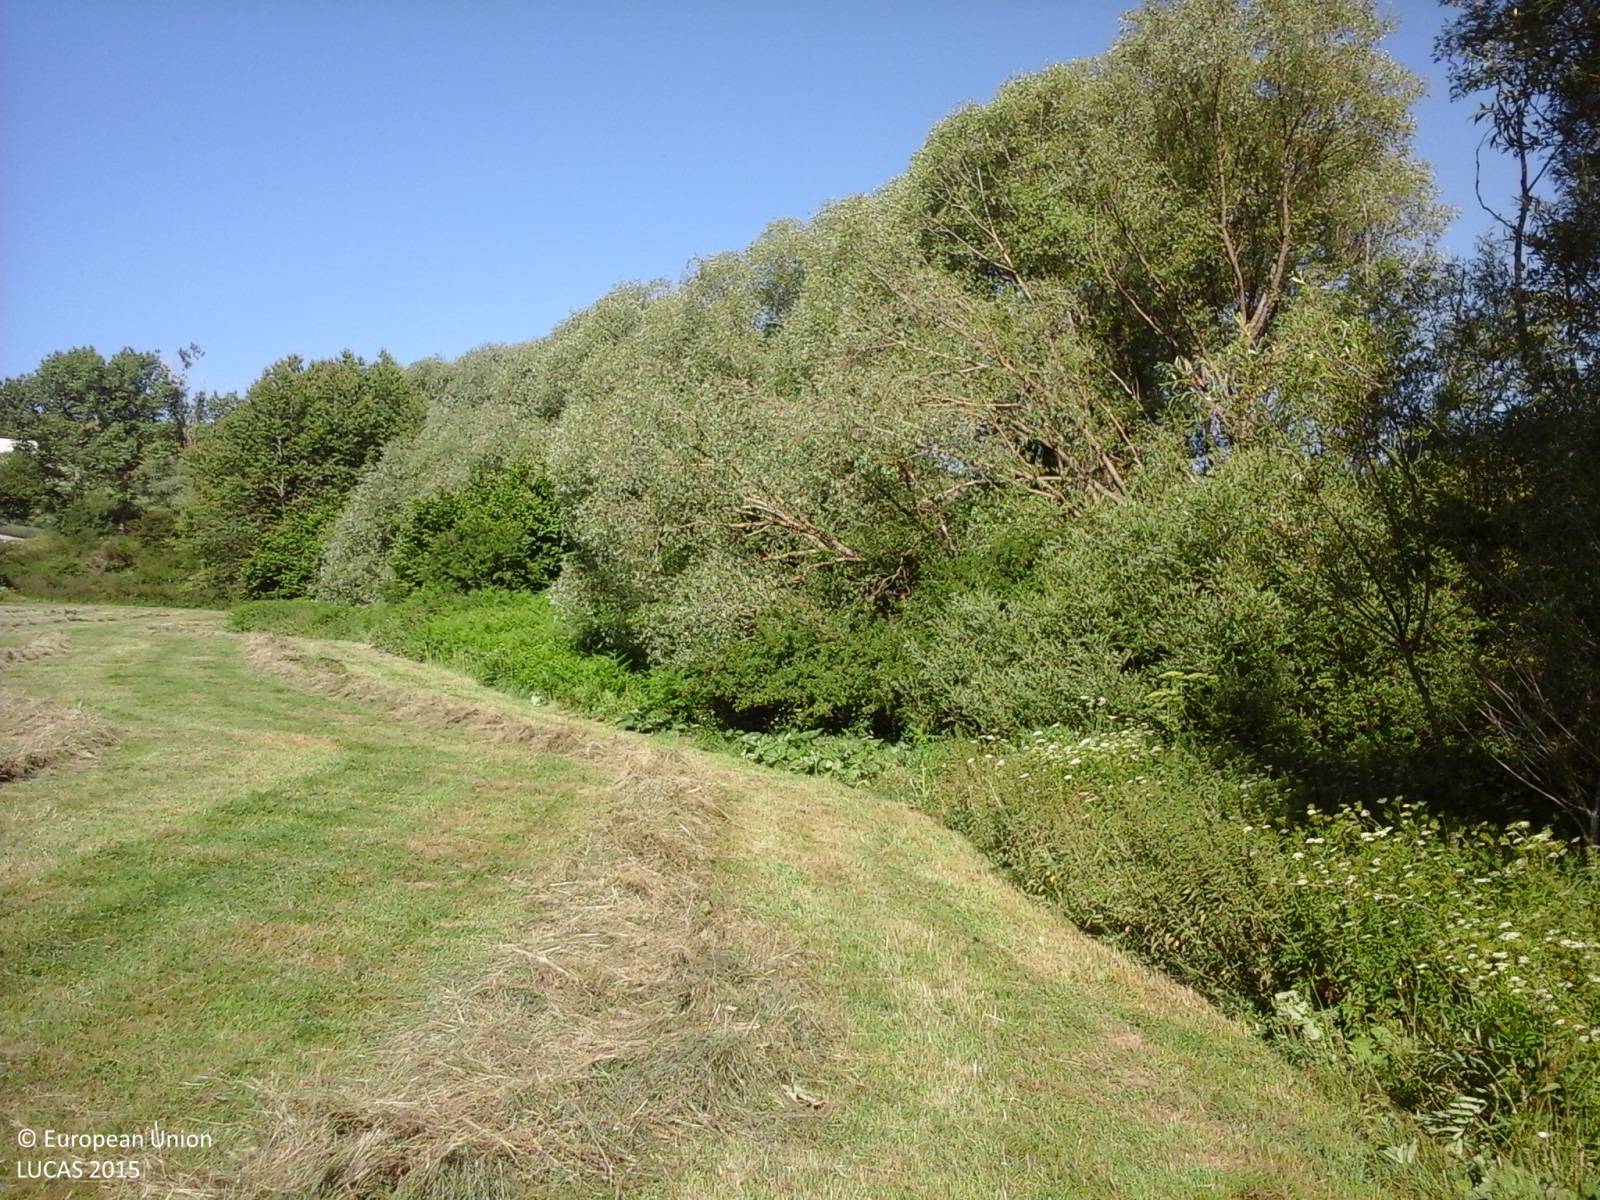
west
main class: Shrubland
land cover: Shrubland without tree cover
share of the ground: > 75 %
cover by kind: shrubs 100 %
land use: Semi-natural and natural areas not in use
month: July
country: IT
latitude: 42.4899
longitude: 13.3596
